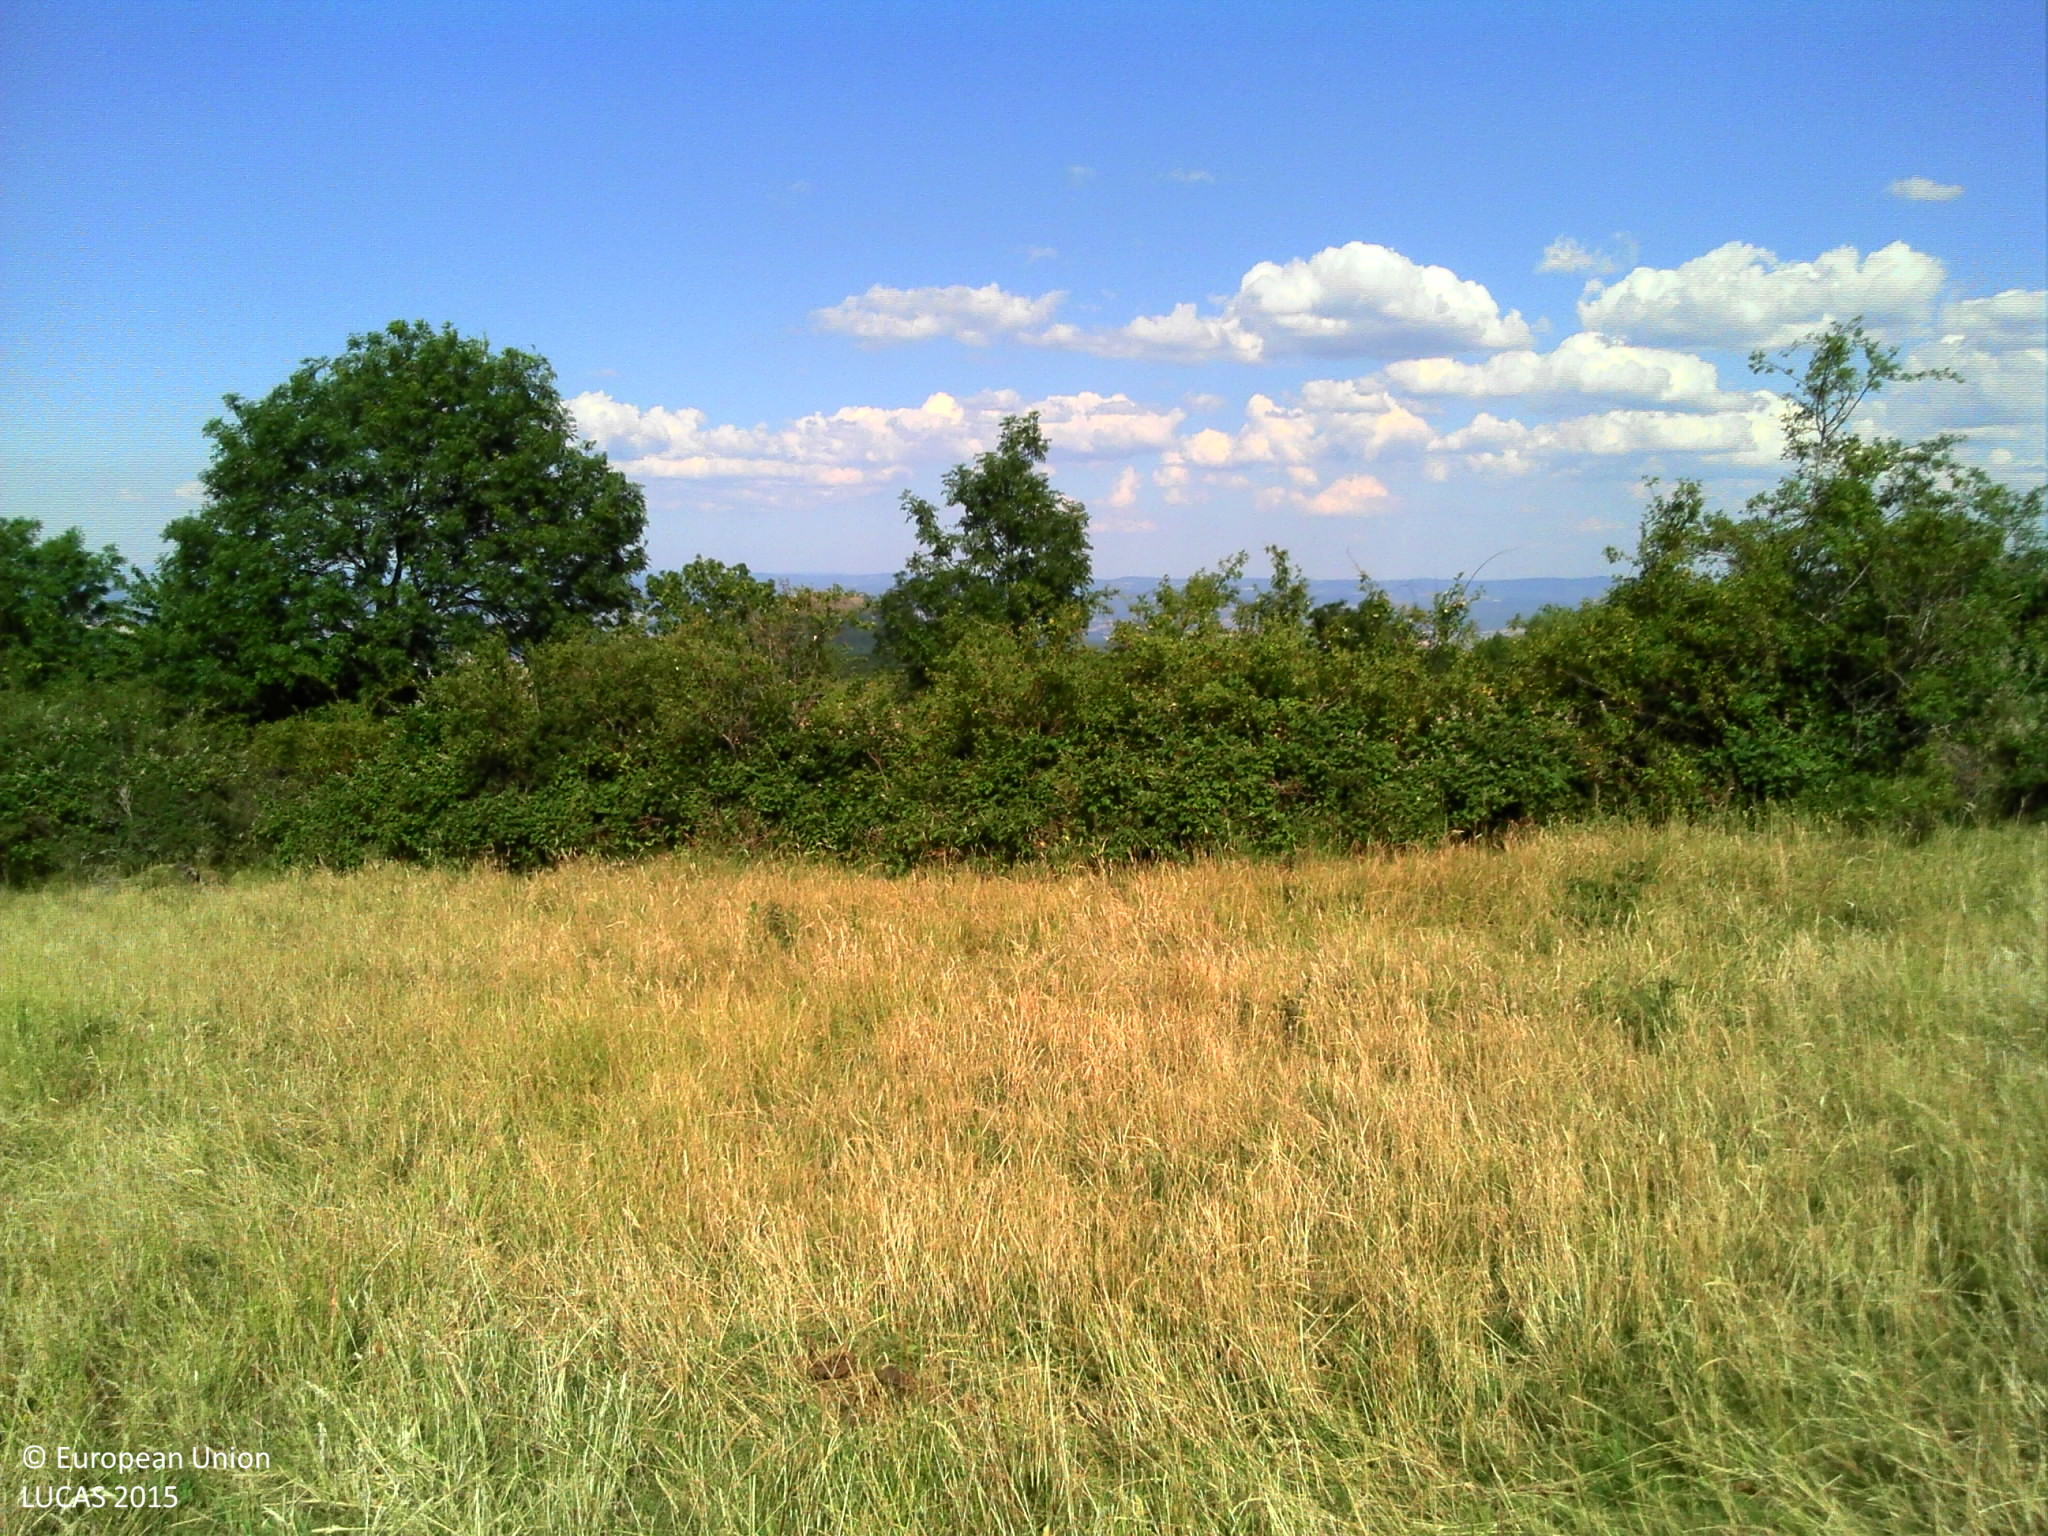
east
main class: Grassland
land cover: Grassland without tree/shrub cover
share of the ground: > 75 %
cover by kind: herbaceous plants 100 %
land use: Agriculture (excluding fallow land and kitchen gardens)
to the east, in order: Grassland without tree/shrub cover; Abandoned hedges; Grassland without tree/shrub cover; Abandoned hedges; Grassland without tree/shrub cover; Electric lines; Grassland without tree/shrub cover; Managed hedges; Fences; Grassland without tree/shrub cover
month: June
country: FR
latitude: 45.5137
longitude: 3.1010
